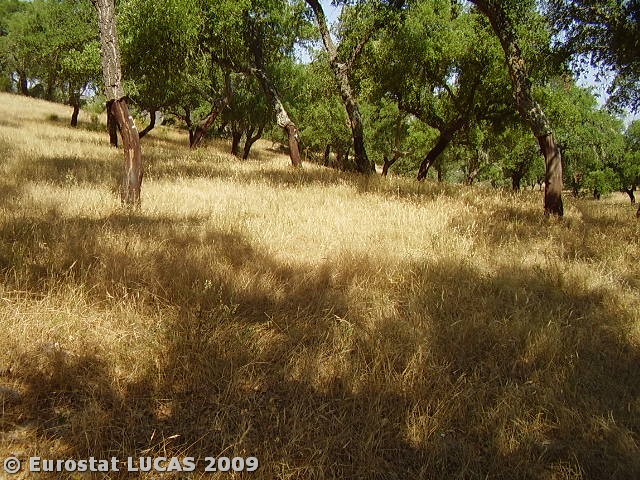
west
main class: Woodland
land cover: Broadleaved woodland
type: broadleaved evergreen forest
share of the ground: 50 - 75 %
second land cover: Spontaneously vegetated surfaces
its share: 25 - 50 %
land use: Forestry
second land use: Fallow land
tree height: > 5 m
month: June
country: PT
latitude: 38.7738
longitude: -7.9896
